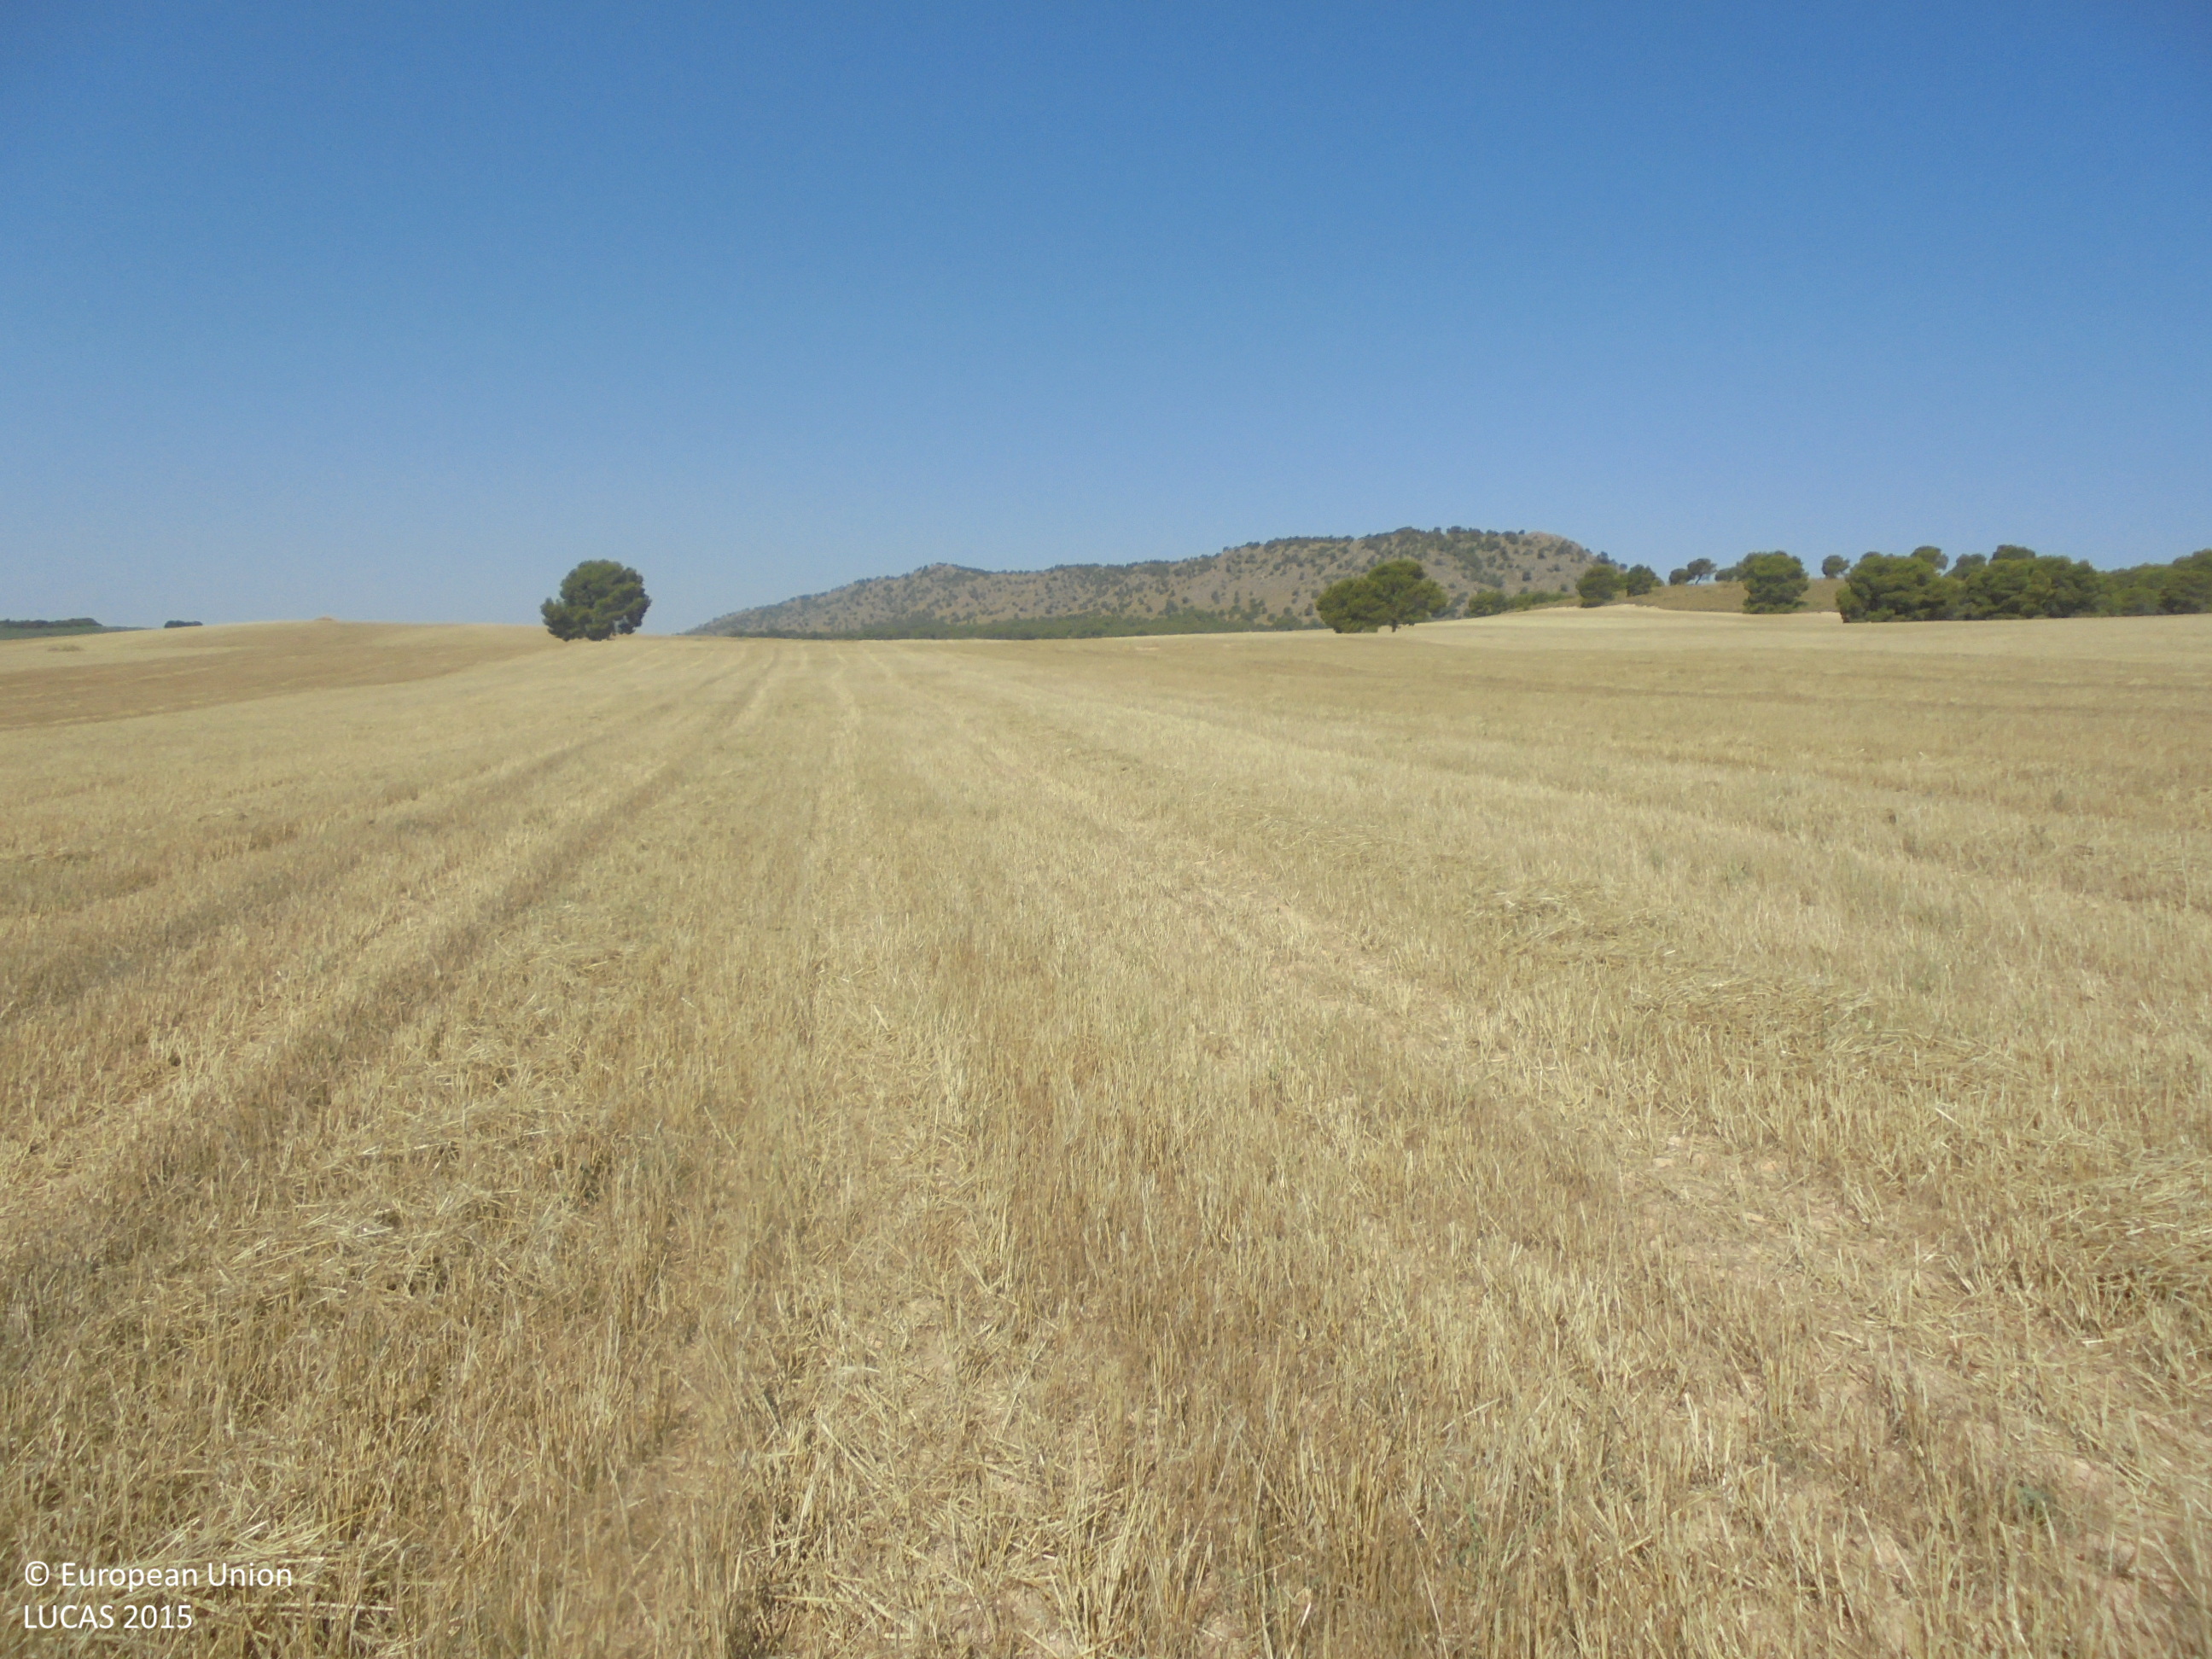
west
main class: Cropland
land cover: Barley
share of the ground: < 10 %
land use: Agriculture (excluding fallow land and kitchen gardens)
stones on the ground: 25 - 50 %
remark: Harvested field
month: July
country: ES
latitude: 38.6698
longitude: -1.5453
